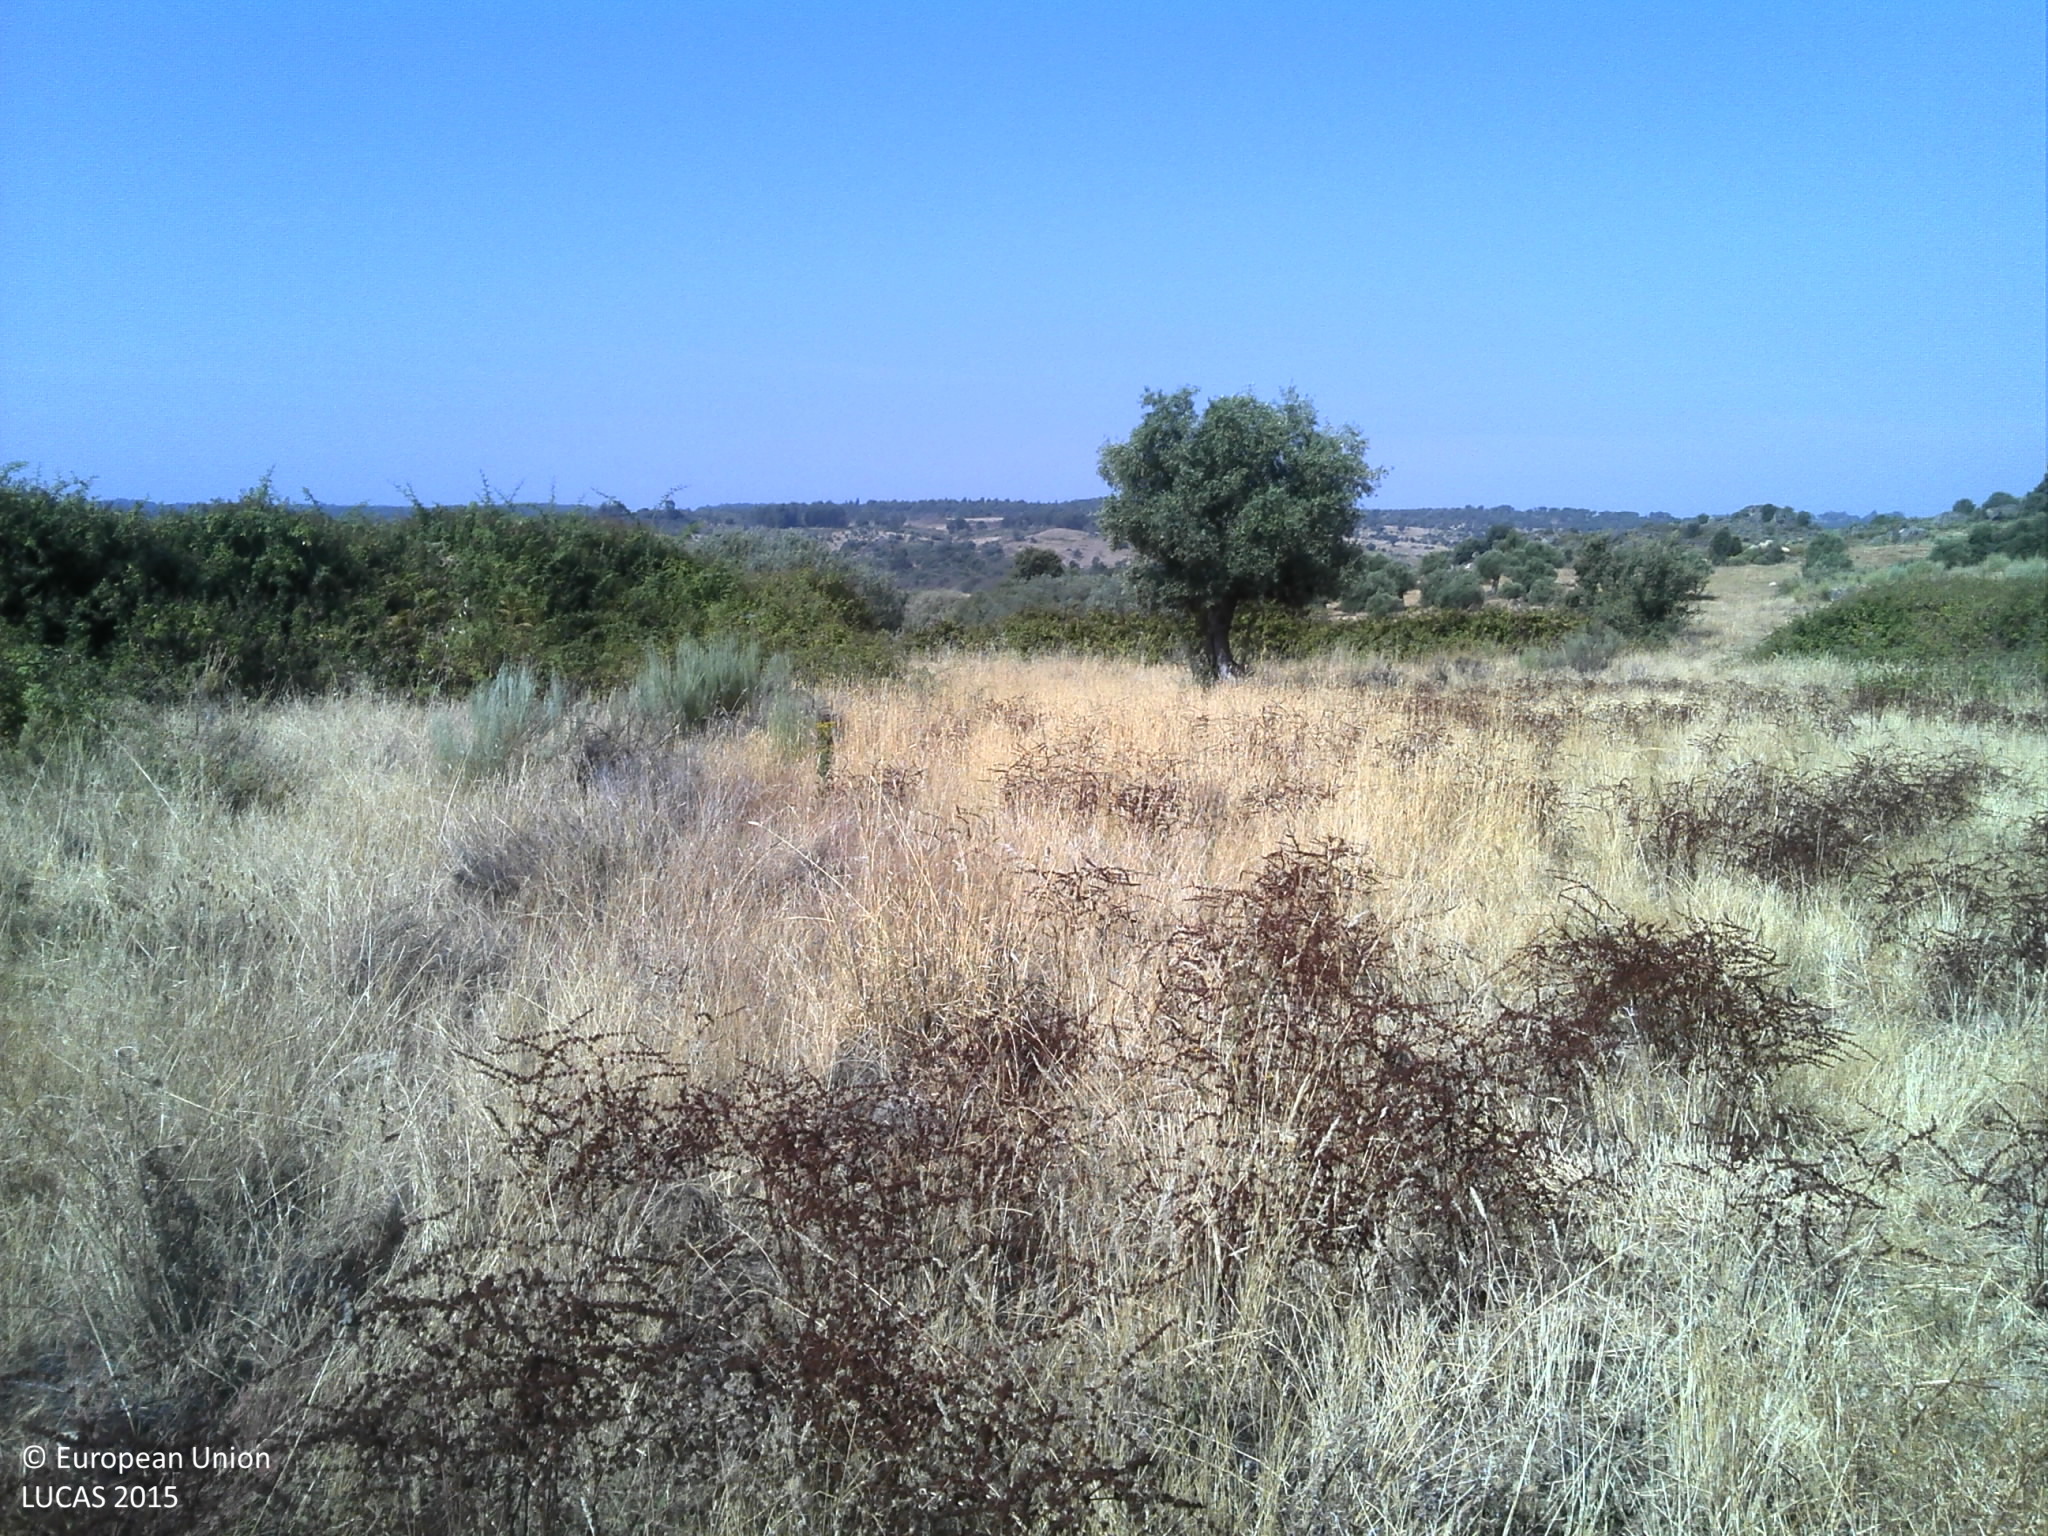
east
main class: Grassland
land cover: Grassland without tree/shrub cover
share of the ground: 50 - 75 %
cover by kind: herbaceous plants 65 %, unconsolidated bare surface 35 %
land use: Agriculture (excluding fallow land and kitchen gardens)
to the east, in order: Grassland without tree/shrub cover; Shrubland without tree cover; Tracks; Shrubland with sparse tree cover; Shrubland without tree cover
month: July
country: PT
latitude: 39.9953
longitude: -7.3751
